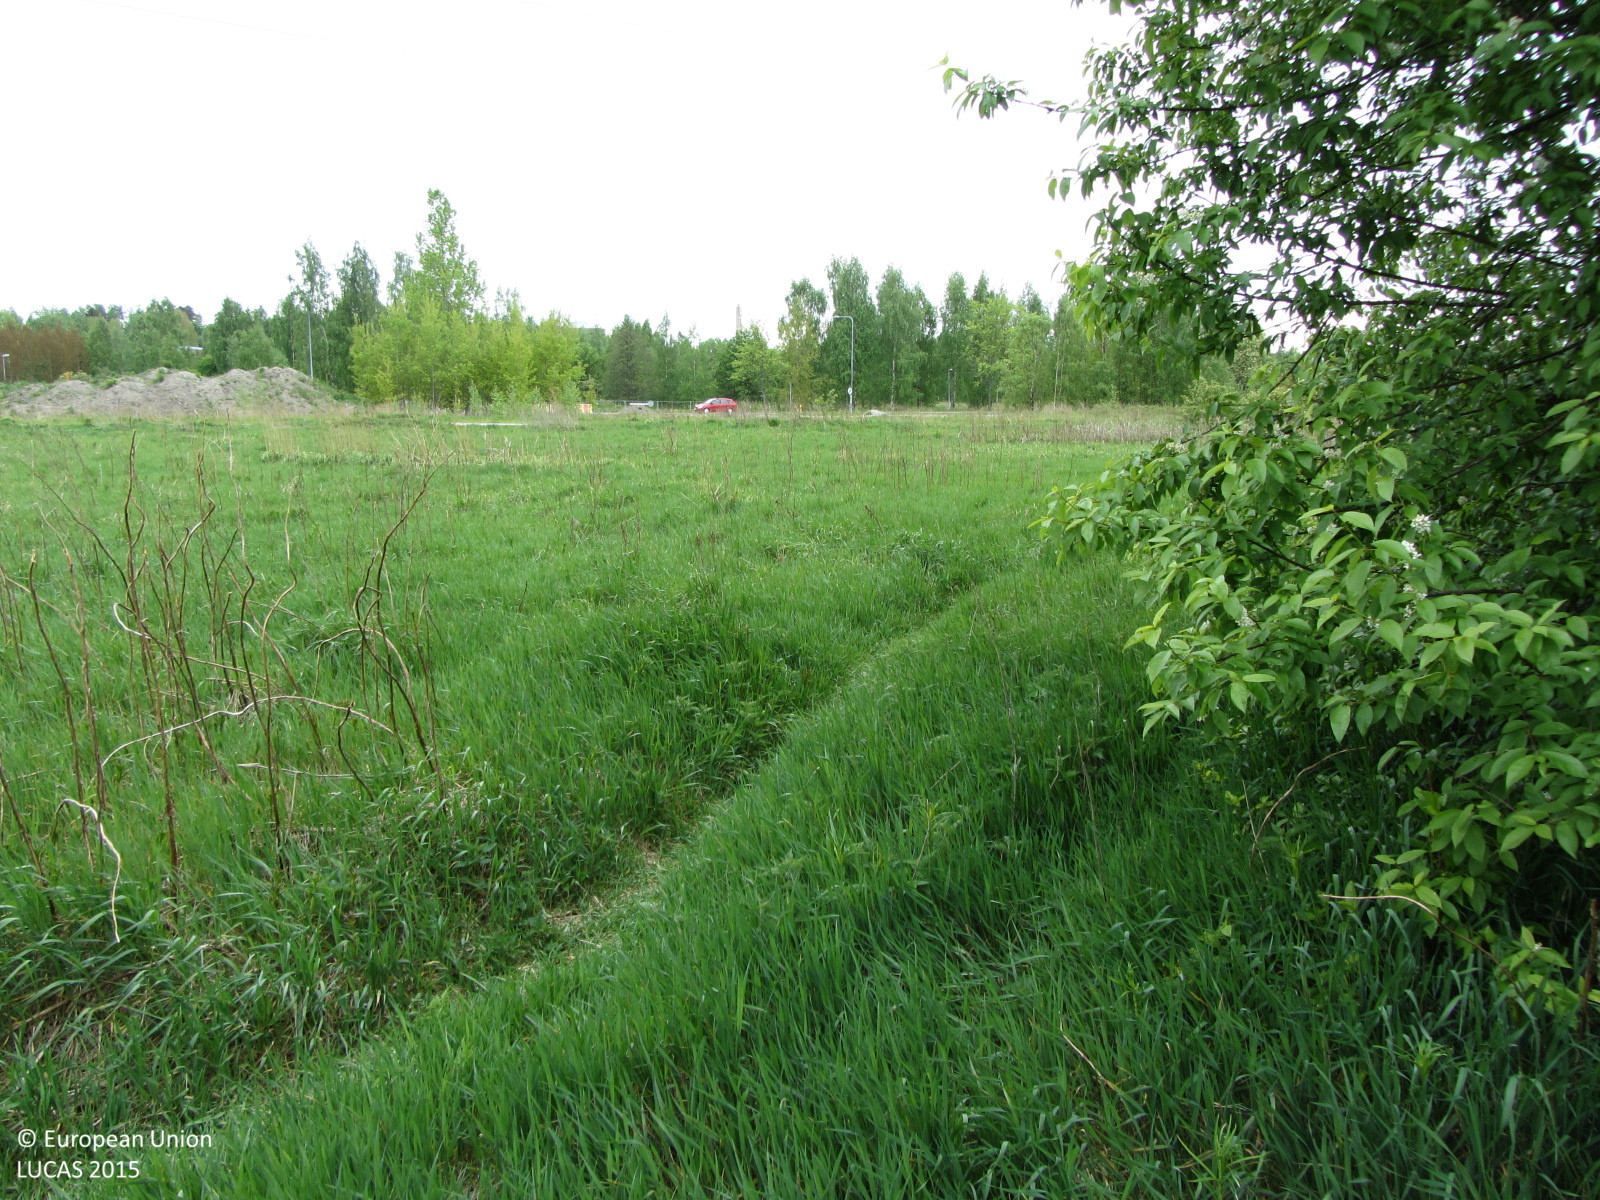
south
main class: Grassland
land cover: Grassland with sparse tree/shrub cover
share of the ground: > 75 %
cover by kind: herbaceous plants 85 %, shrubs 10 %, broadleaved forest trees 5 %
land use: Semi-natural and natural areas not in use
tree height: < 5 m
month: June
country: FI
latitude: 60.1860
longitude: 24.7742
